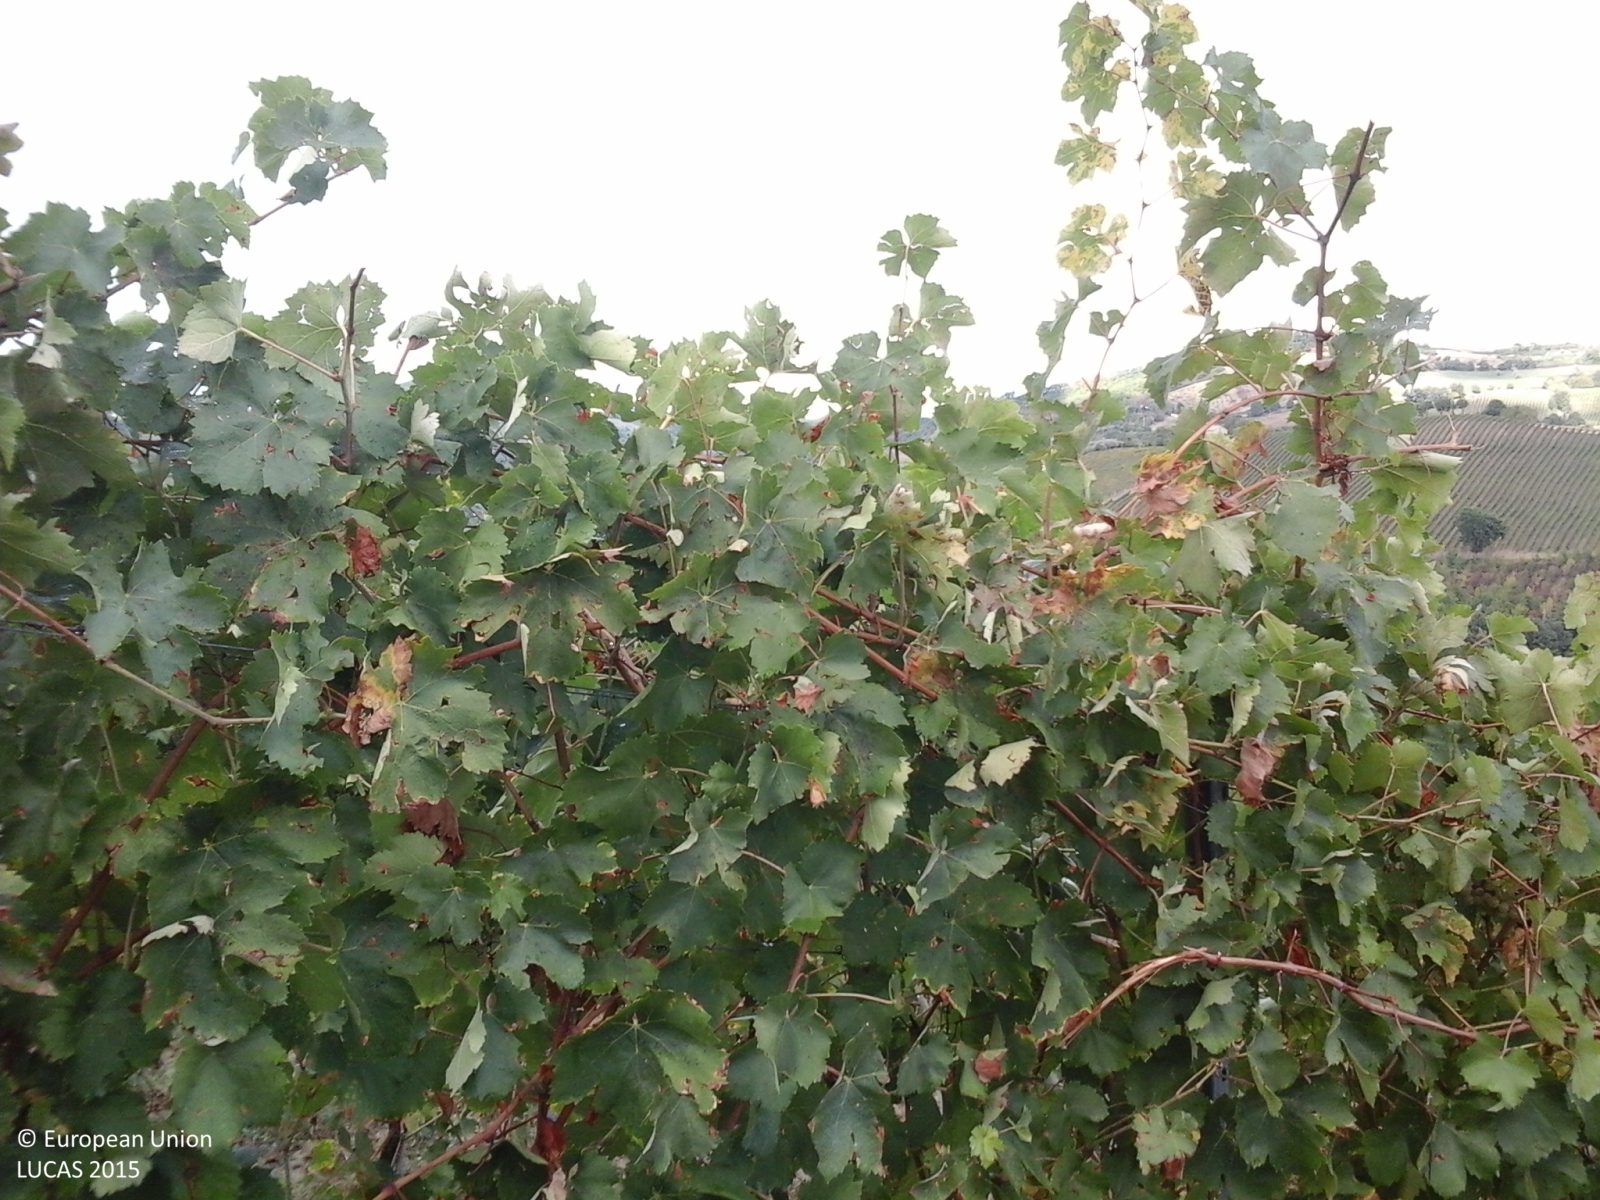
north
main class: Cropland
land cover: Vineyards
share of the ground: 50 - 75 %
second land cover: Other bare soil
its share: > 75 %
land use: Agriculture (excluding fallow land and kitchen gardens)
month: September
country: IT
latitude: 43.4364
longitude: 13.1424
